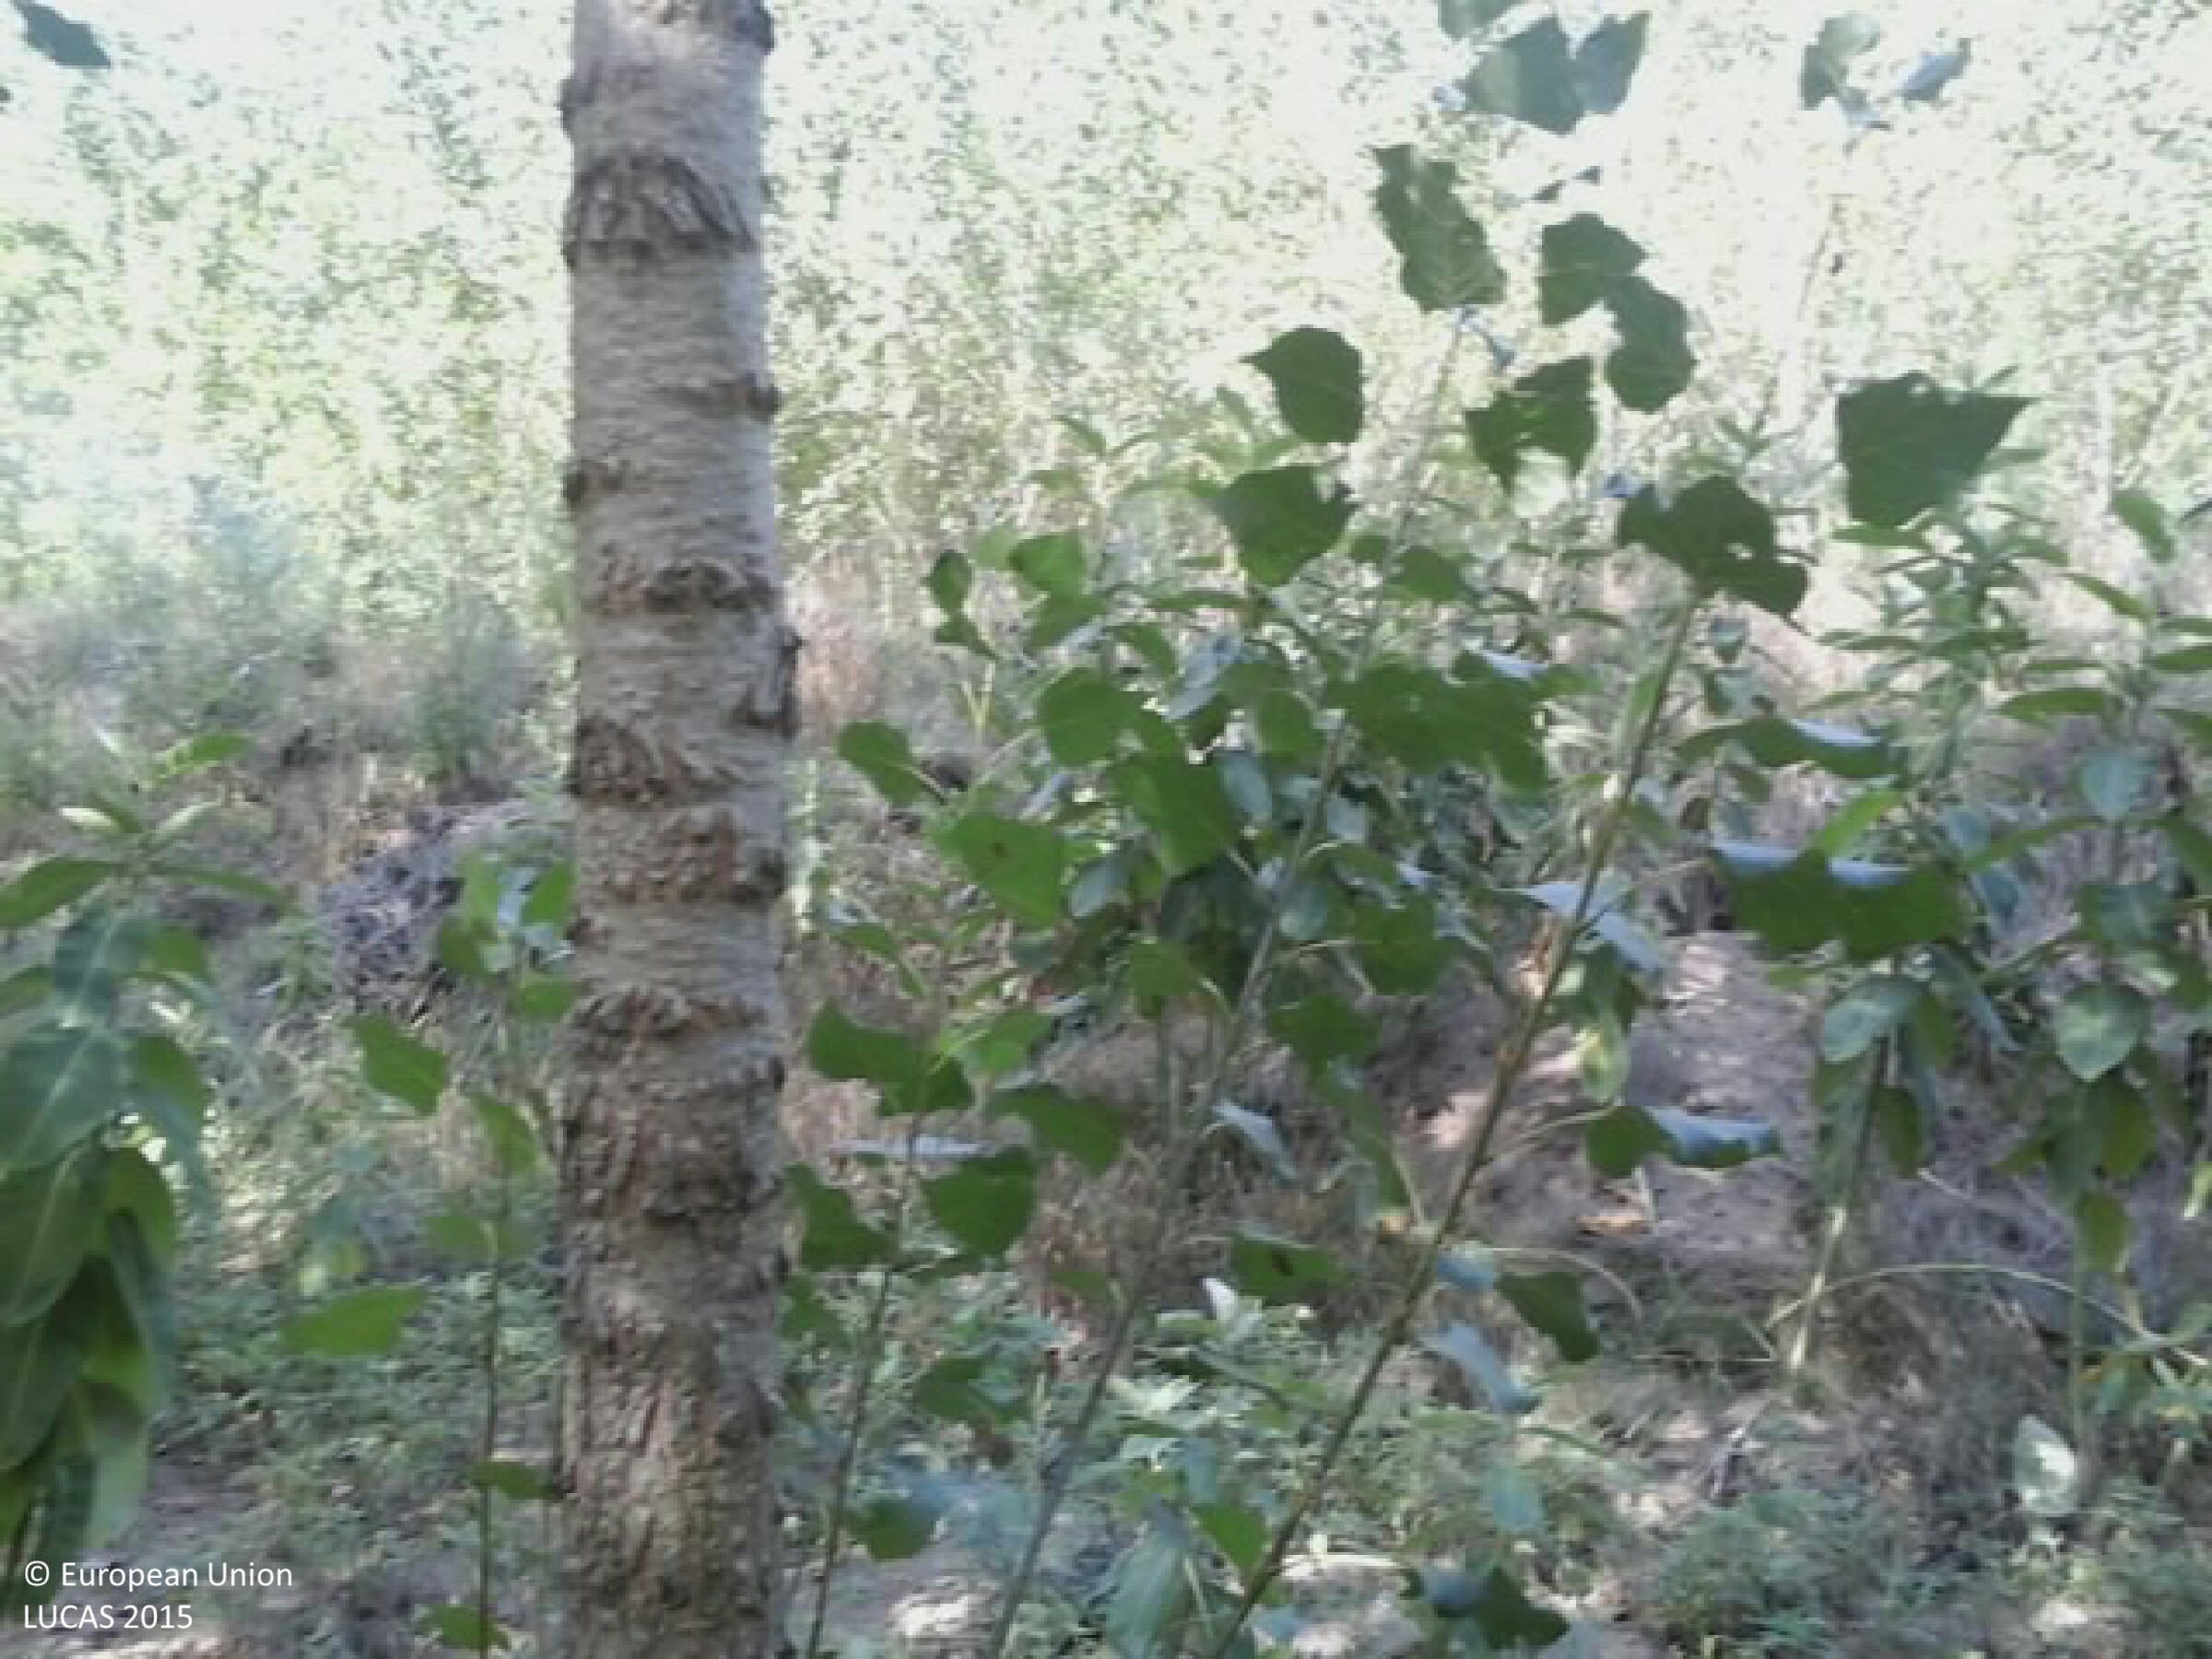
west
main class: Woodland
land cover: Broadleaved woodland
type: non-riverine alder, birch or aspen forest
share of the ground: 50 - 75 %
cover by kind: broadleaved forest trees 85 %, unconsolidated bare surface 15 %
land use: Forestry
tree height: > 5 m
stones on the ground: < 10 %
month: August
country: HU
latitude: 47.0782
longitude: 19.8080
